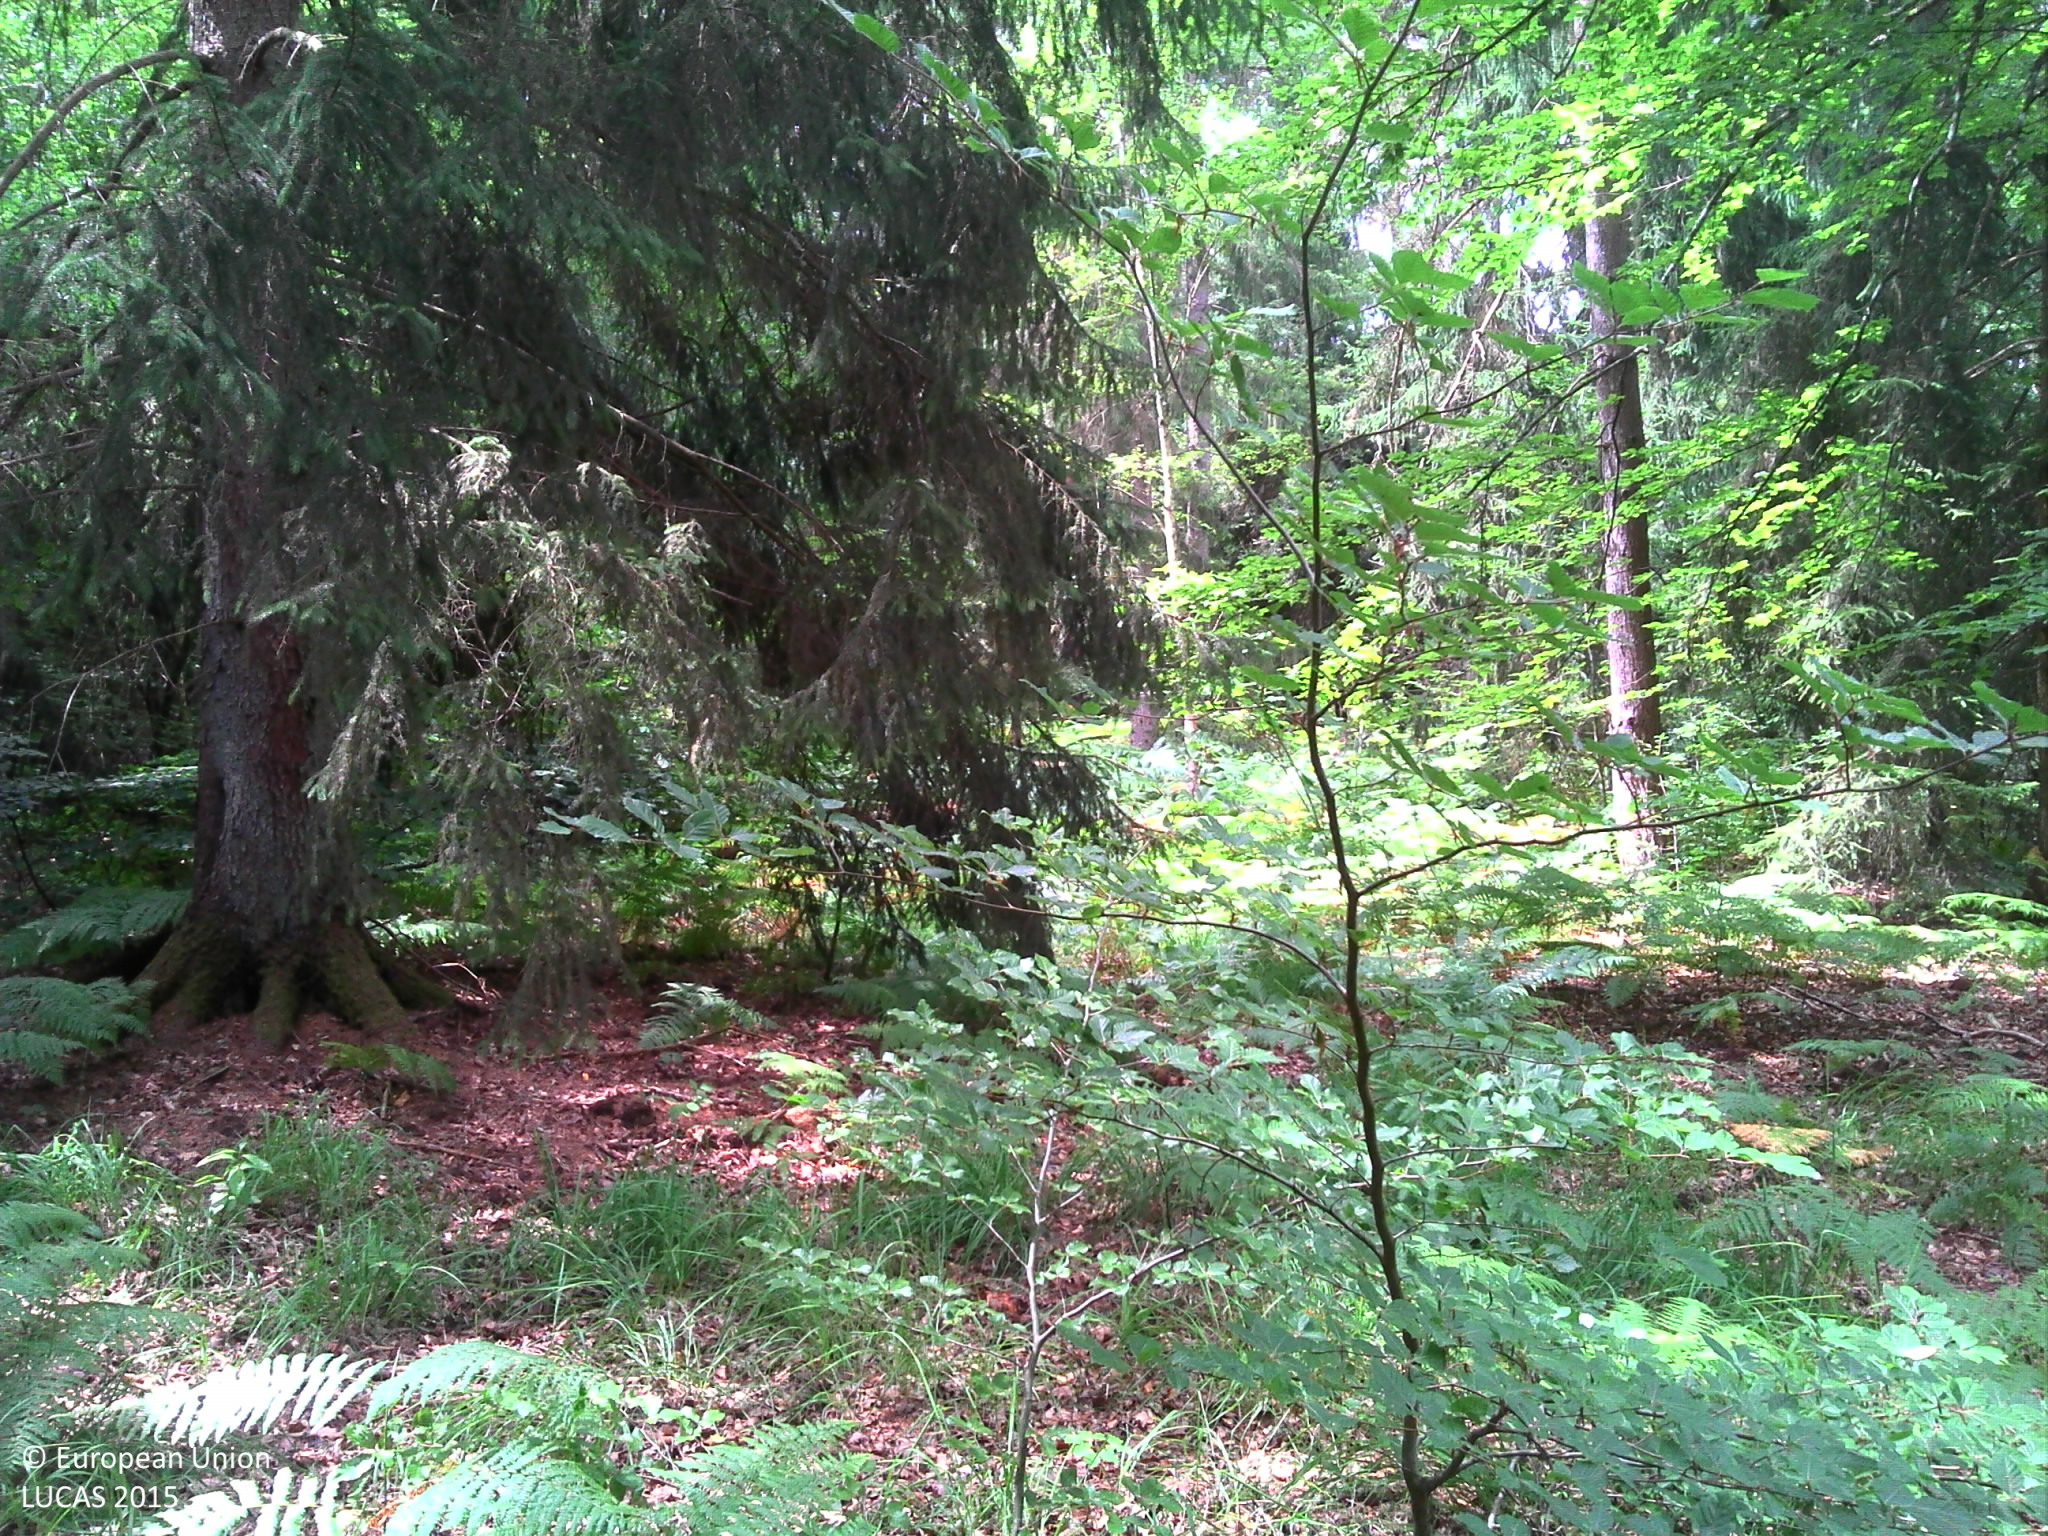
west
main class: Woodland
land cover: Pine dominated mixed woodland
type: hemiboreal forest and nemoral coniferous forest and mixed broadleaved-coniferous forest
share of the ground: > 75 %
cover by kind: coniferous forest trees 40 %, broadleaved forest trees 20 %, herbaceous plants 15 %, lichens and mosses 10 %, unconsolidated bare surface 10 %
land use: Forestry
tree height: > 5 m
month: July
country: FR
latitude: 48.4352
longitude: 2.7324
